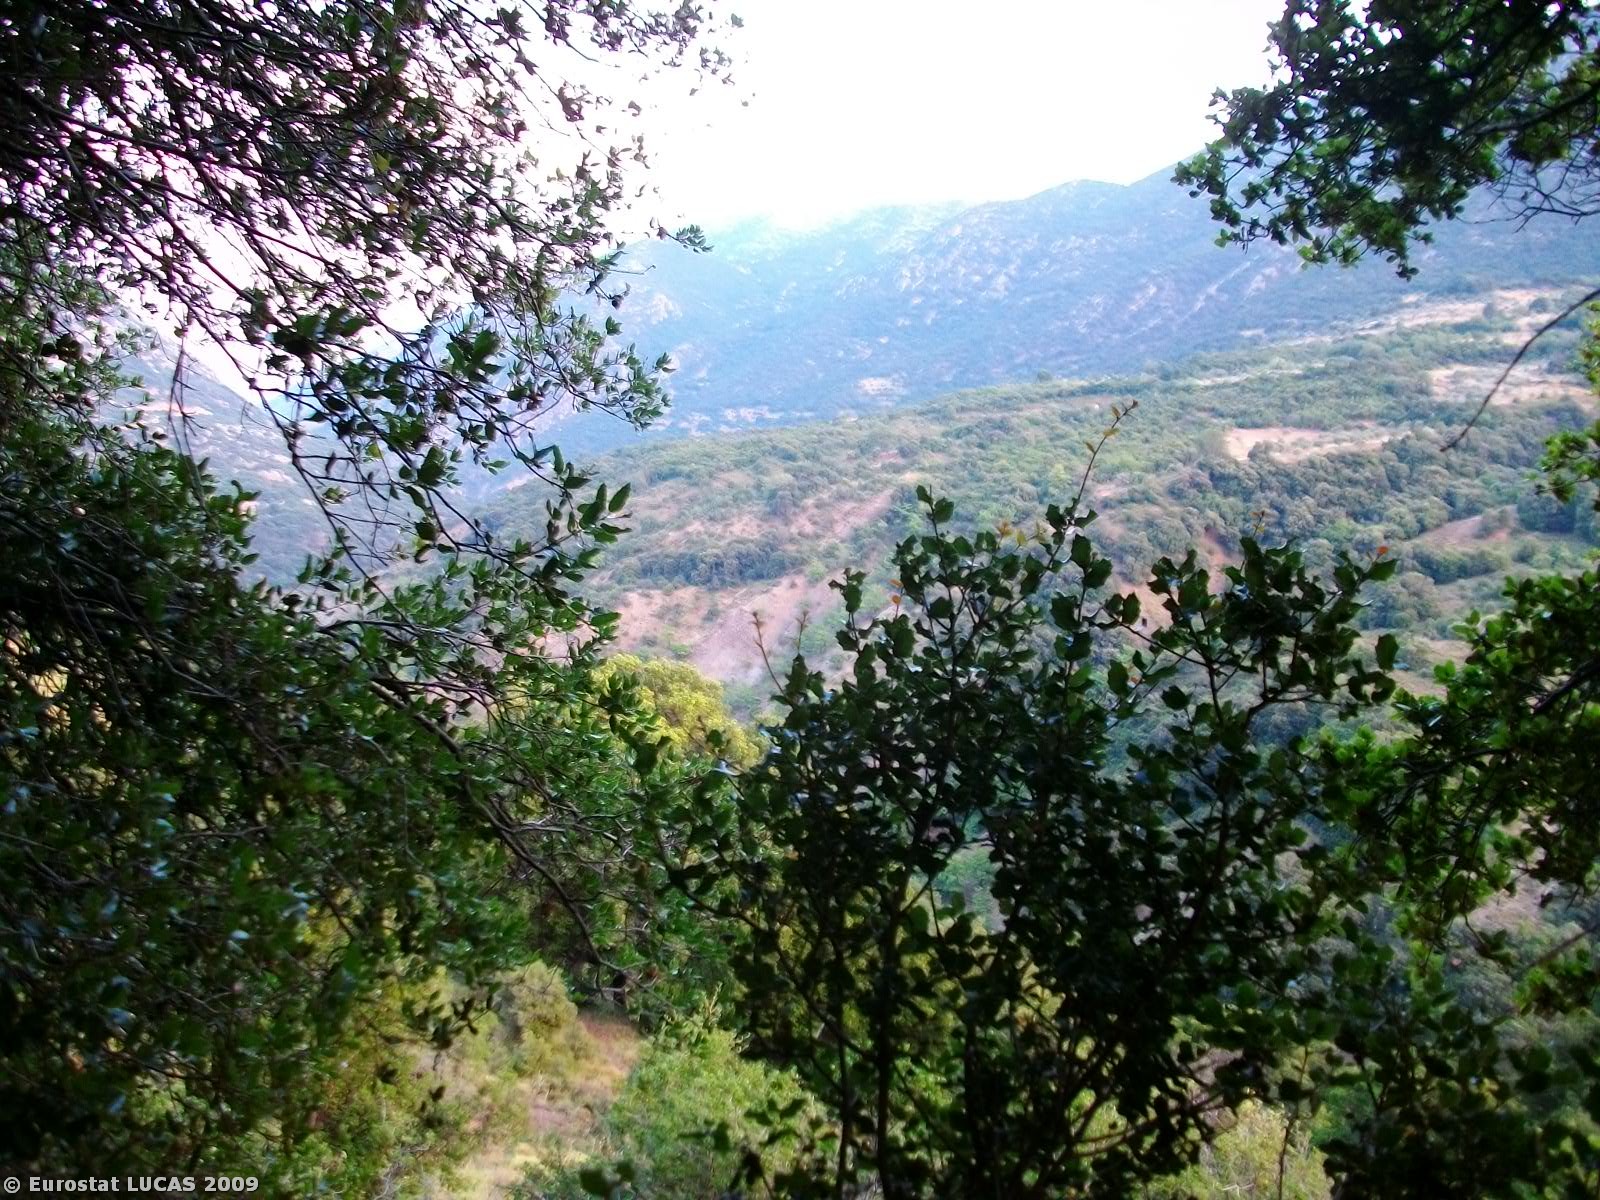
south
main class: Shrubland
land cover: Shrubland with sparse tree cover
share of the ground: > 75 %
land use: Agriculture (excluding fallow land and kitchen gardens)
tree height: < 5 m
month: July
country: GR
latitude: 38.4303
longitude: 22.1495
